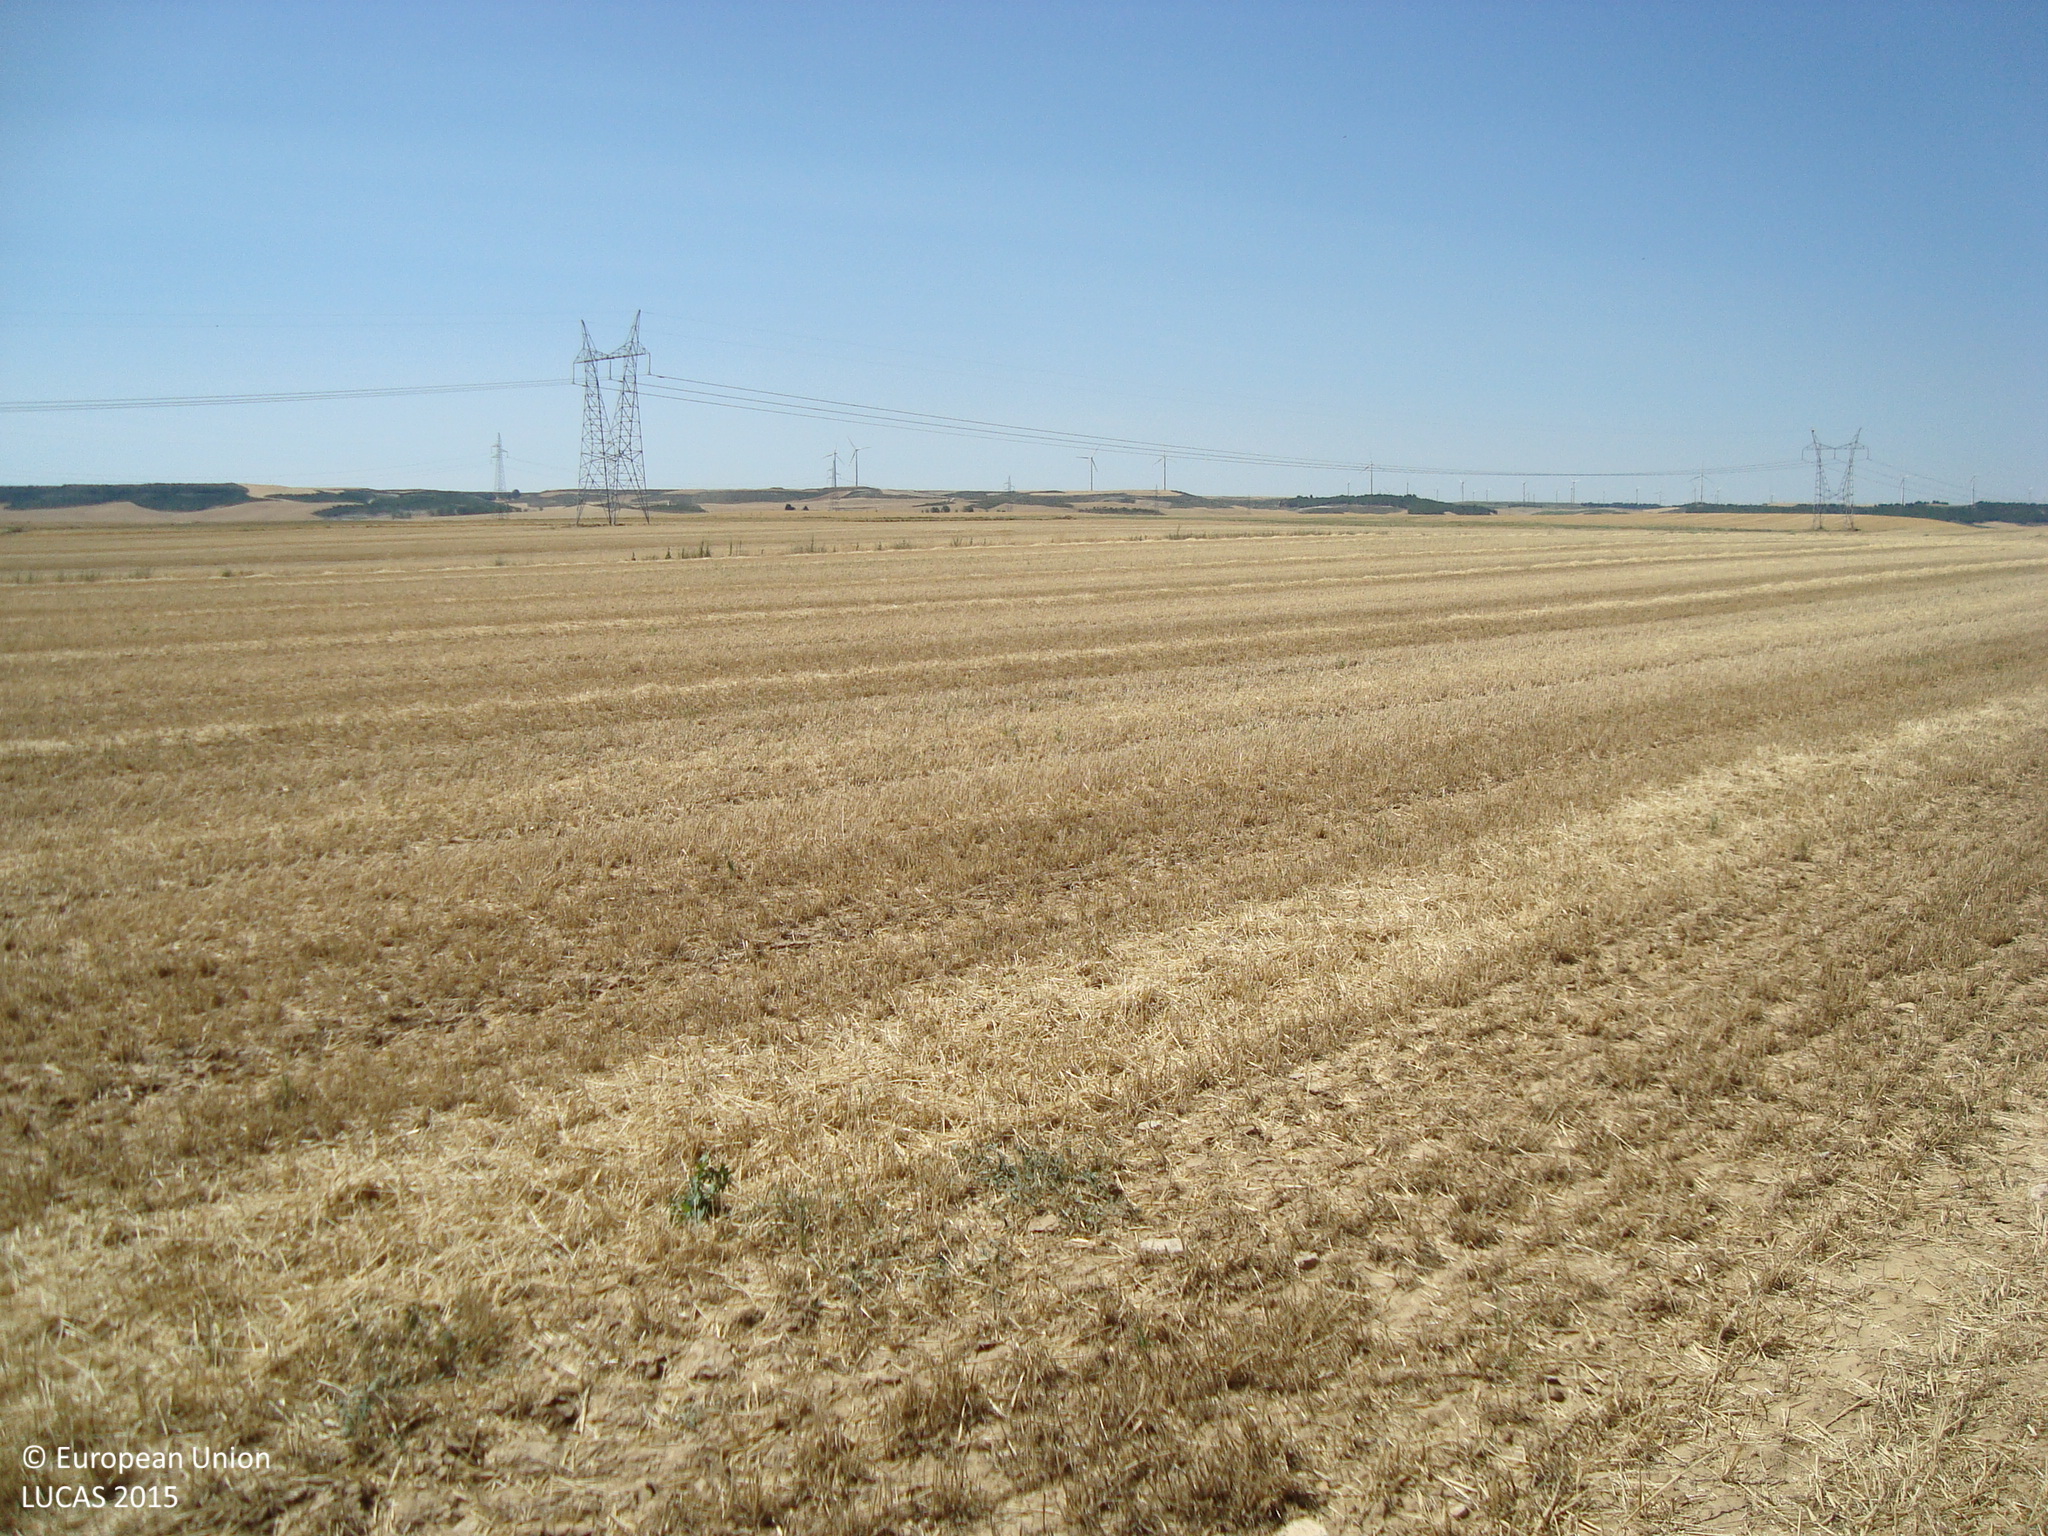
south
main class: Cropland
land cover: Barley
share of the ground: < 10 %
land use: Agriculture (excluding fallow land and kitchen gardens)
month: July
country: ES
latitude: 41.9974
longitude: -4.6924
